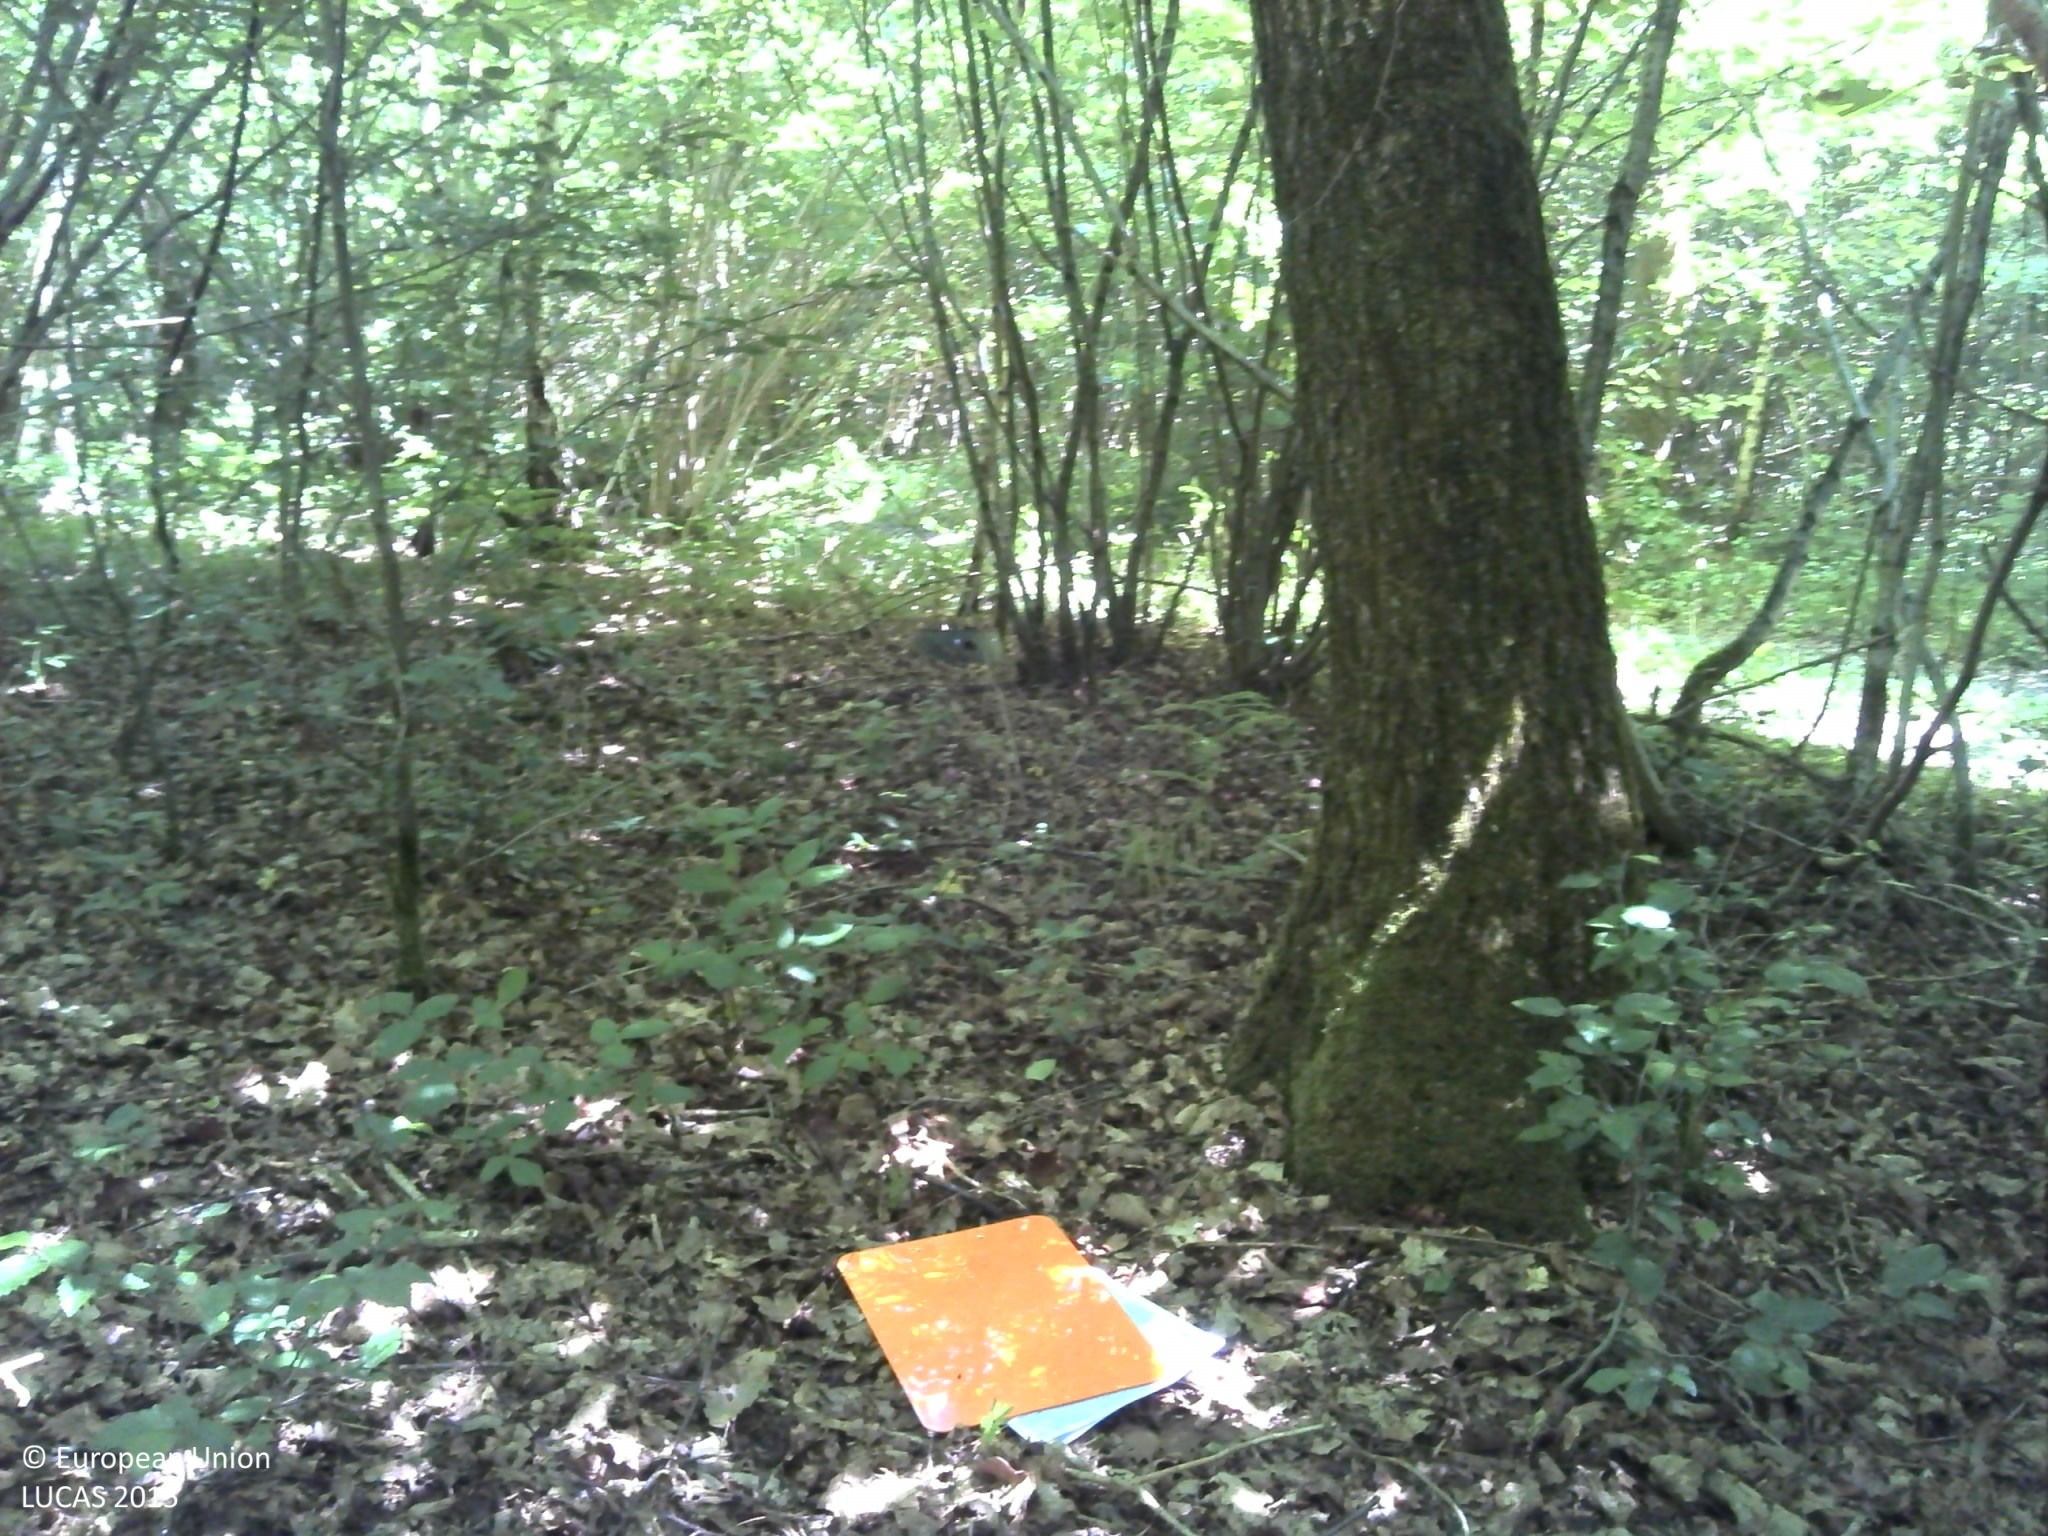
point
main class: Woodland
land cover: Broadleaved woodland
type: acidophilous oak and oak-birch forest
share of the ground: > 75 %
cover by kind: broadleaved forest trees 70 %, herbaceous plants 15 %, consolidated bare surface 10 %, lichens and mosses 5 %
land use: Forestry
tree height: > 5 m
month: June
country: FR
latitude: 50.0291
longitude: 4.7899
